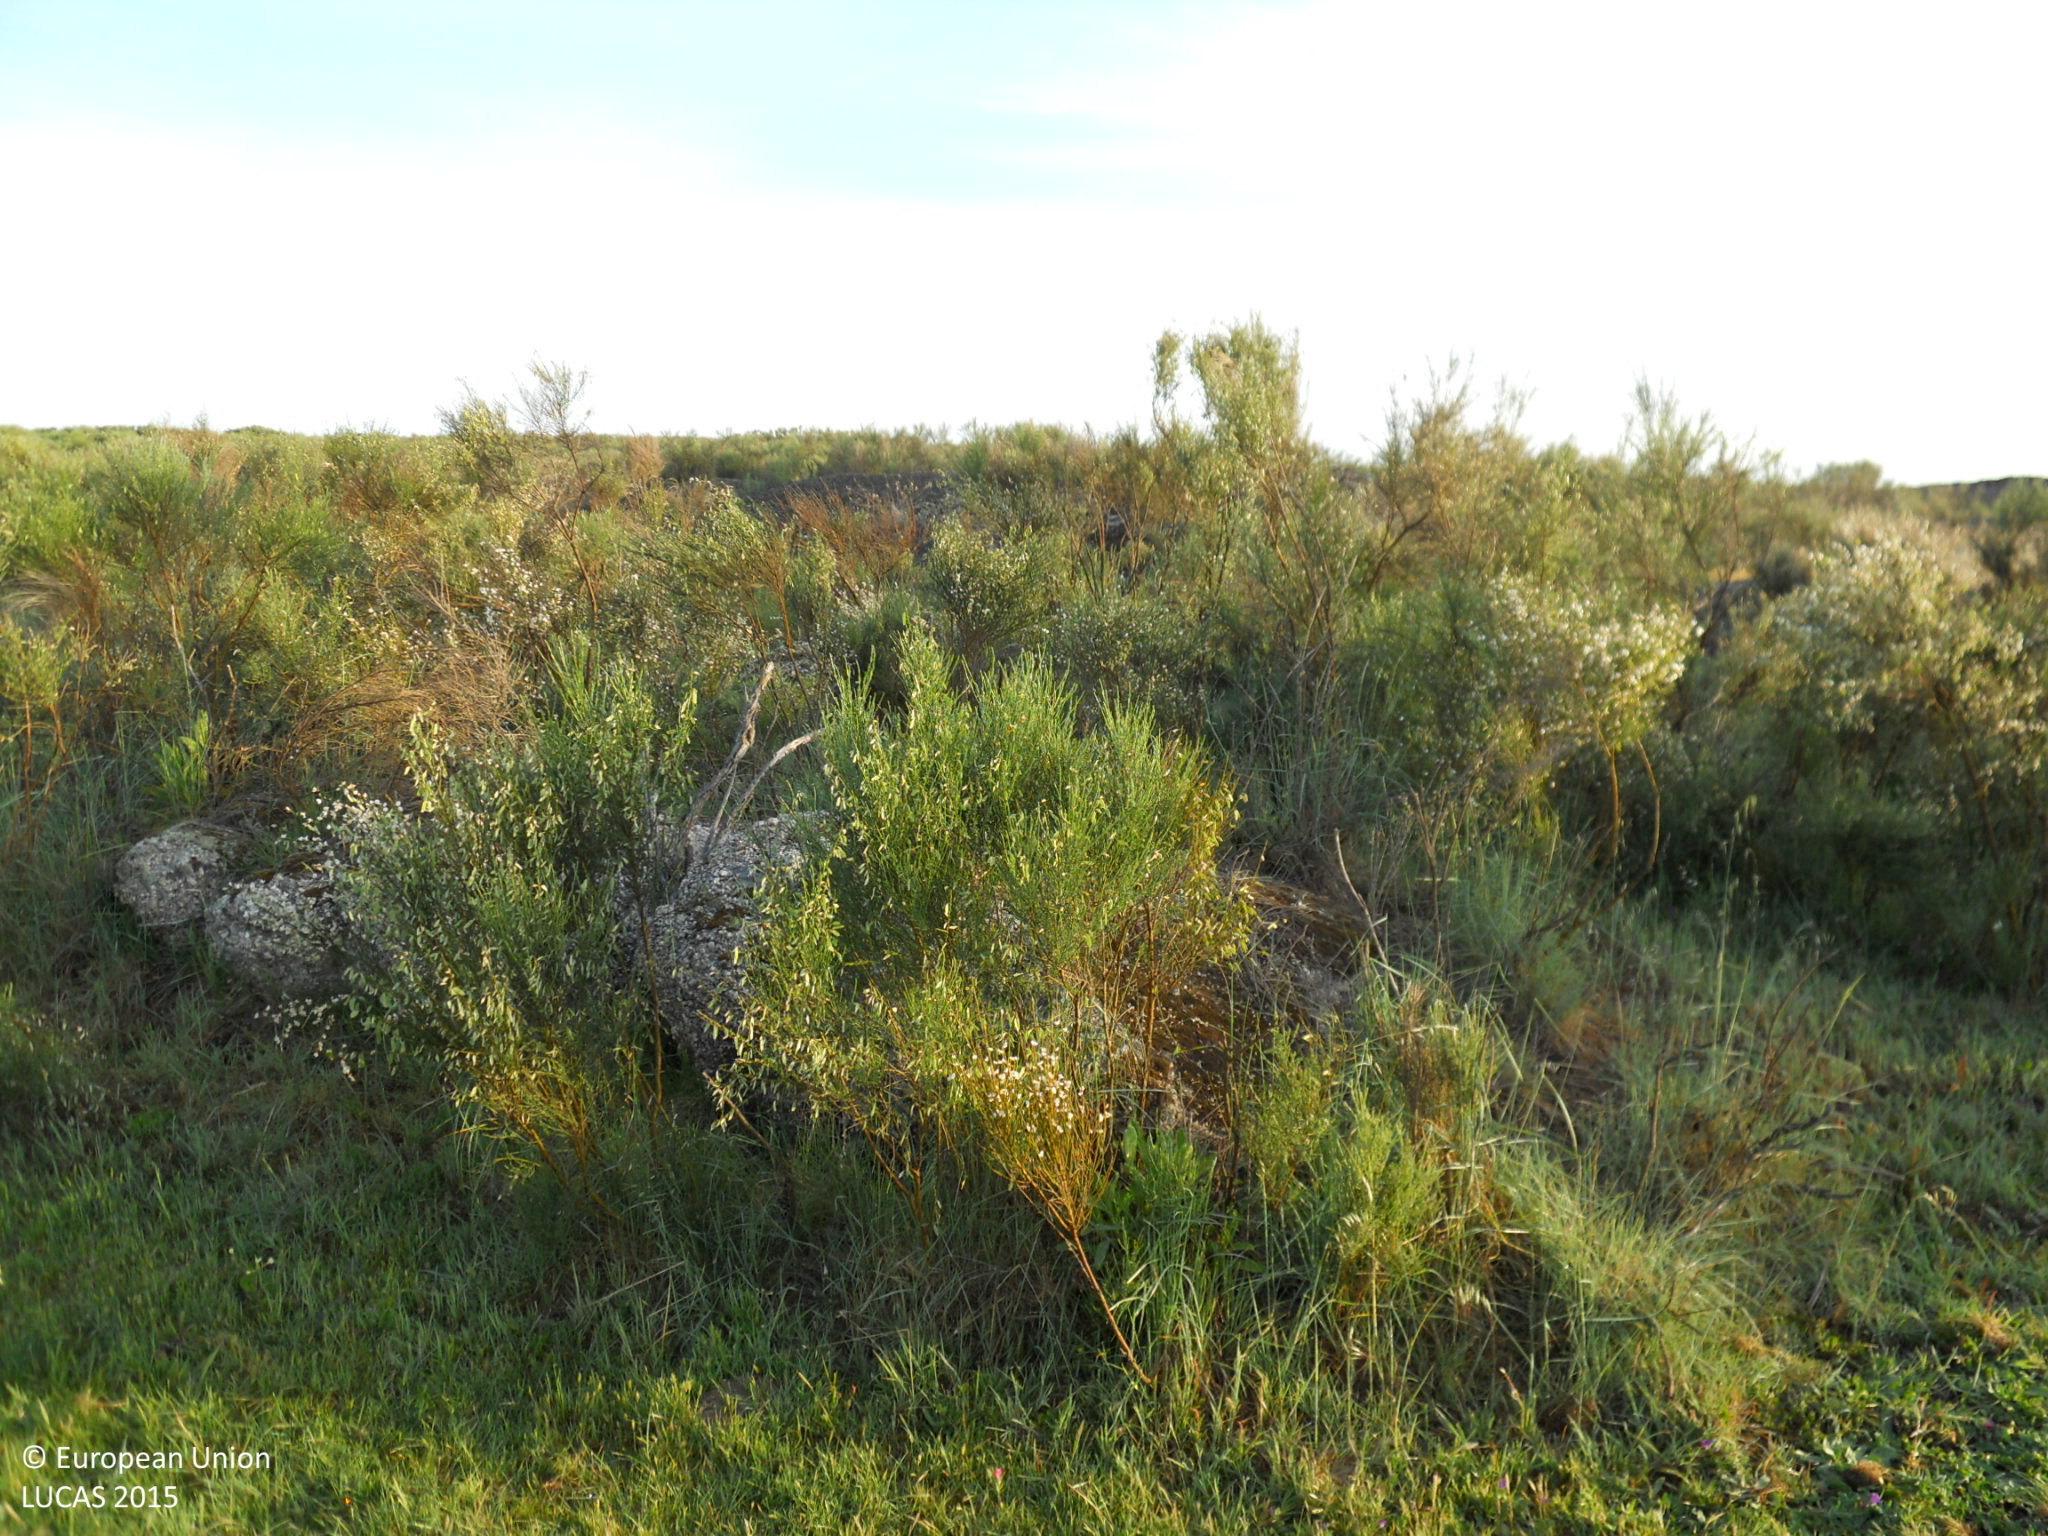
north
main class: Grassland
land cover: Grassland with sparse tree/shrub cover
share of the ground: > 75 %
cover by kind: herbaceous plants 90 %, broadleaved forest trees 5 %, shrubs 5 %
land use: Agriculture (excluding fallow land and kitchen gardens)
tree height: < 5 m
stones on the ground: 10 - 25 %
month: April
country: ES
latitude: 39.2769
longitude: -7.0614
